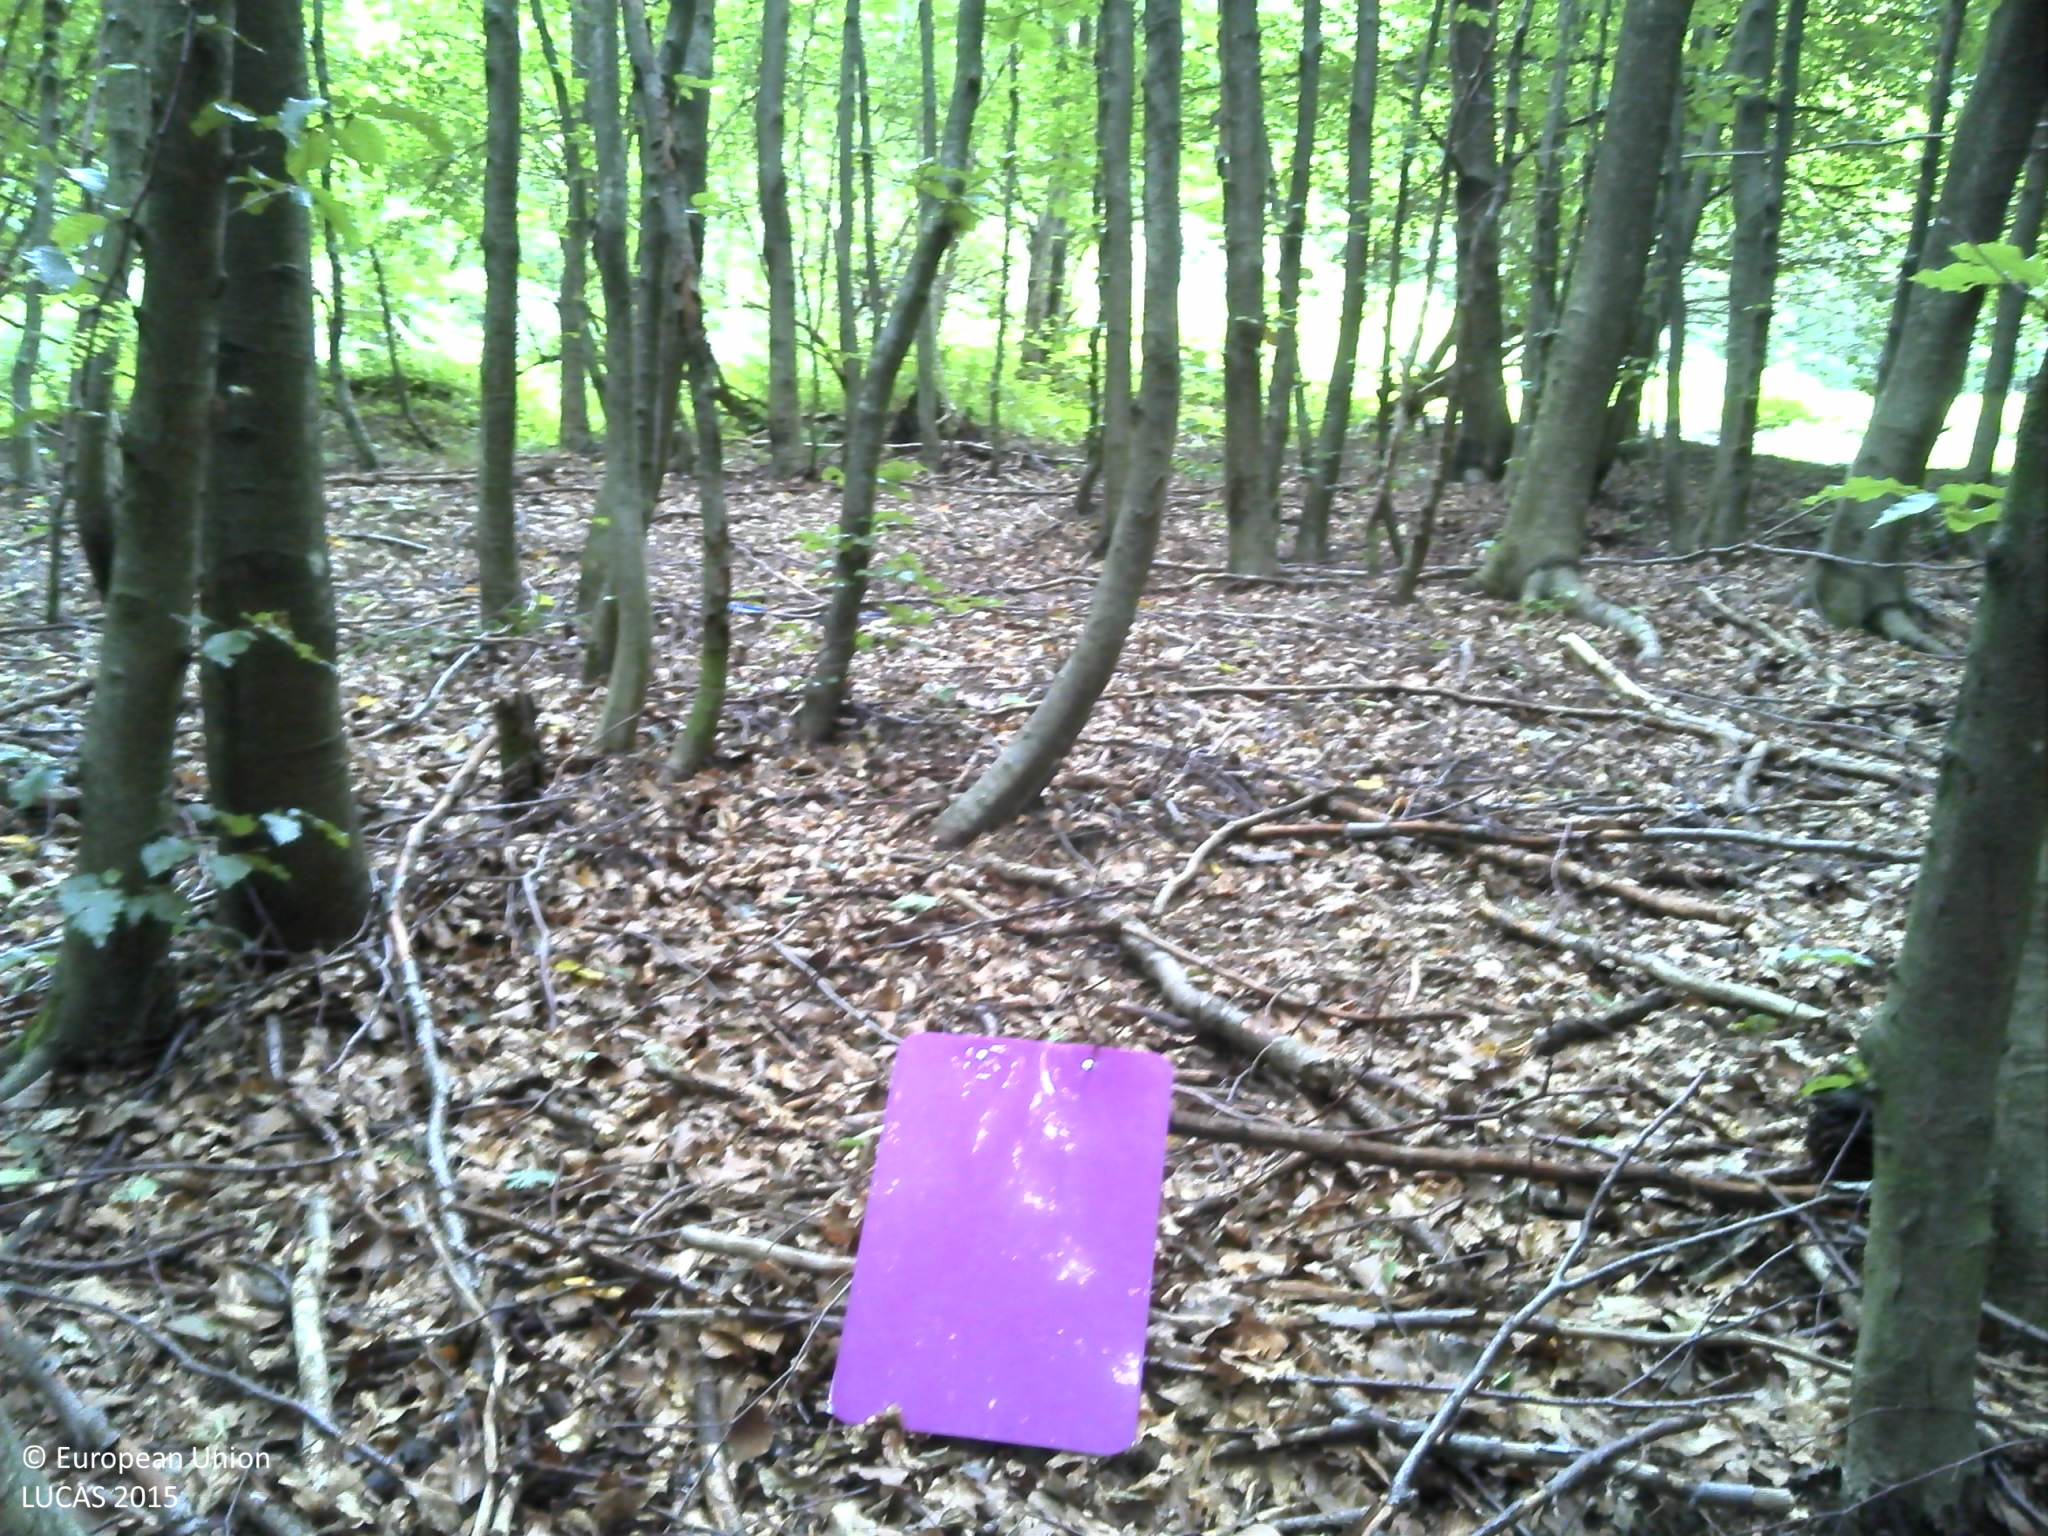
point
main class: Woodland
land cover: Broadleaved woodland
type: beech forest
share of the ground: > 75 %
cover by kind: broadleaved forest trees 100 %
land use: Forestry
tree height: > 5 m
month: July
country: HR
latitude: 45.6619
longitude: 17.3815
